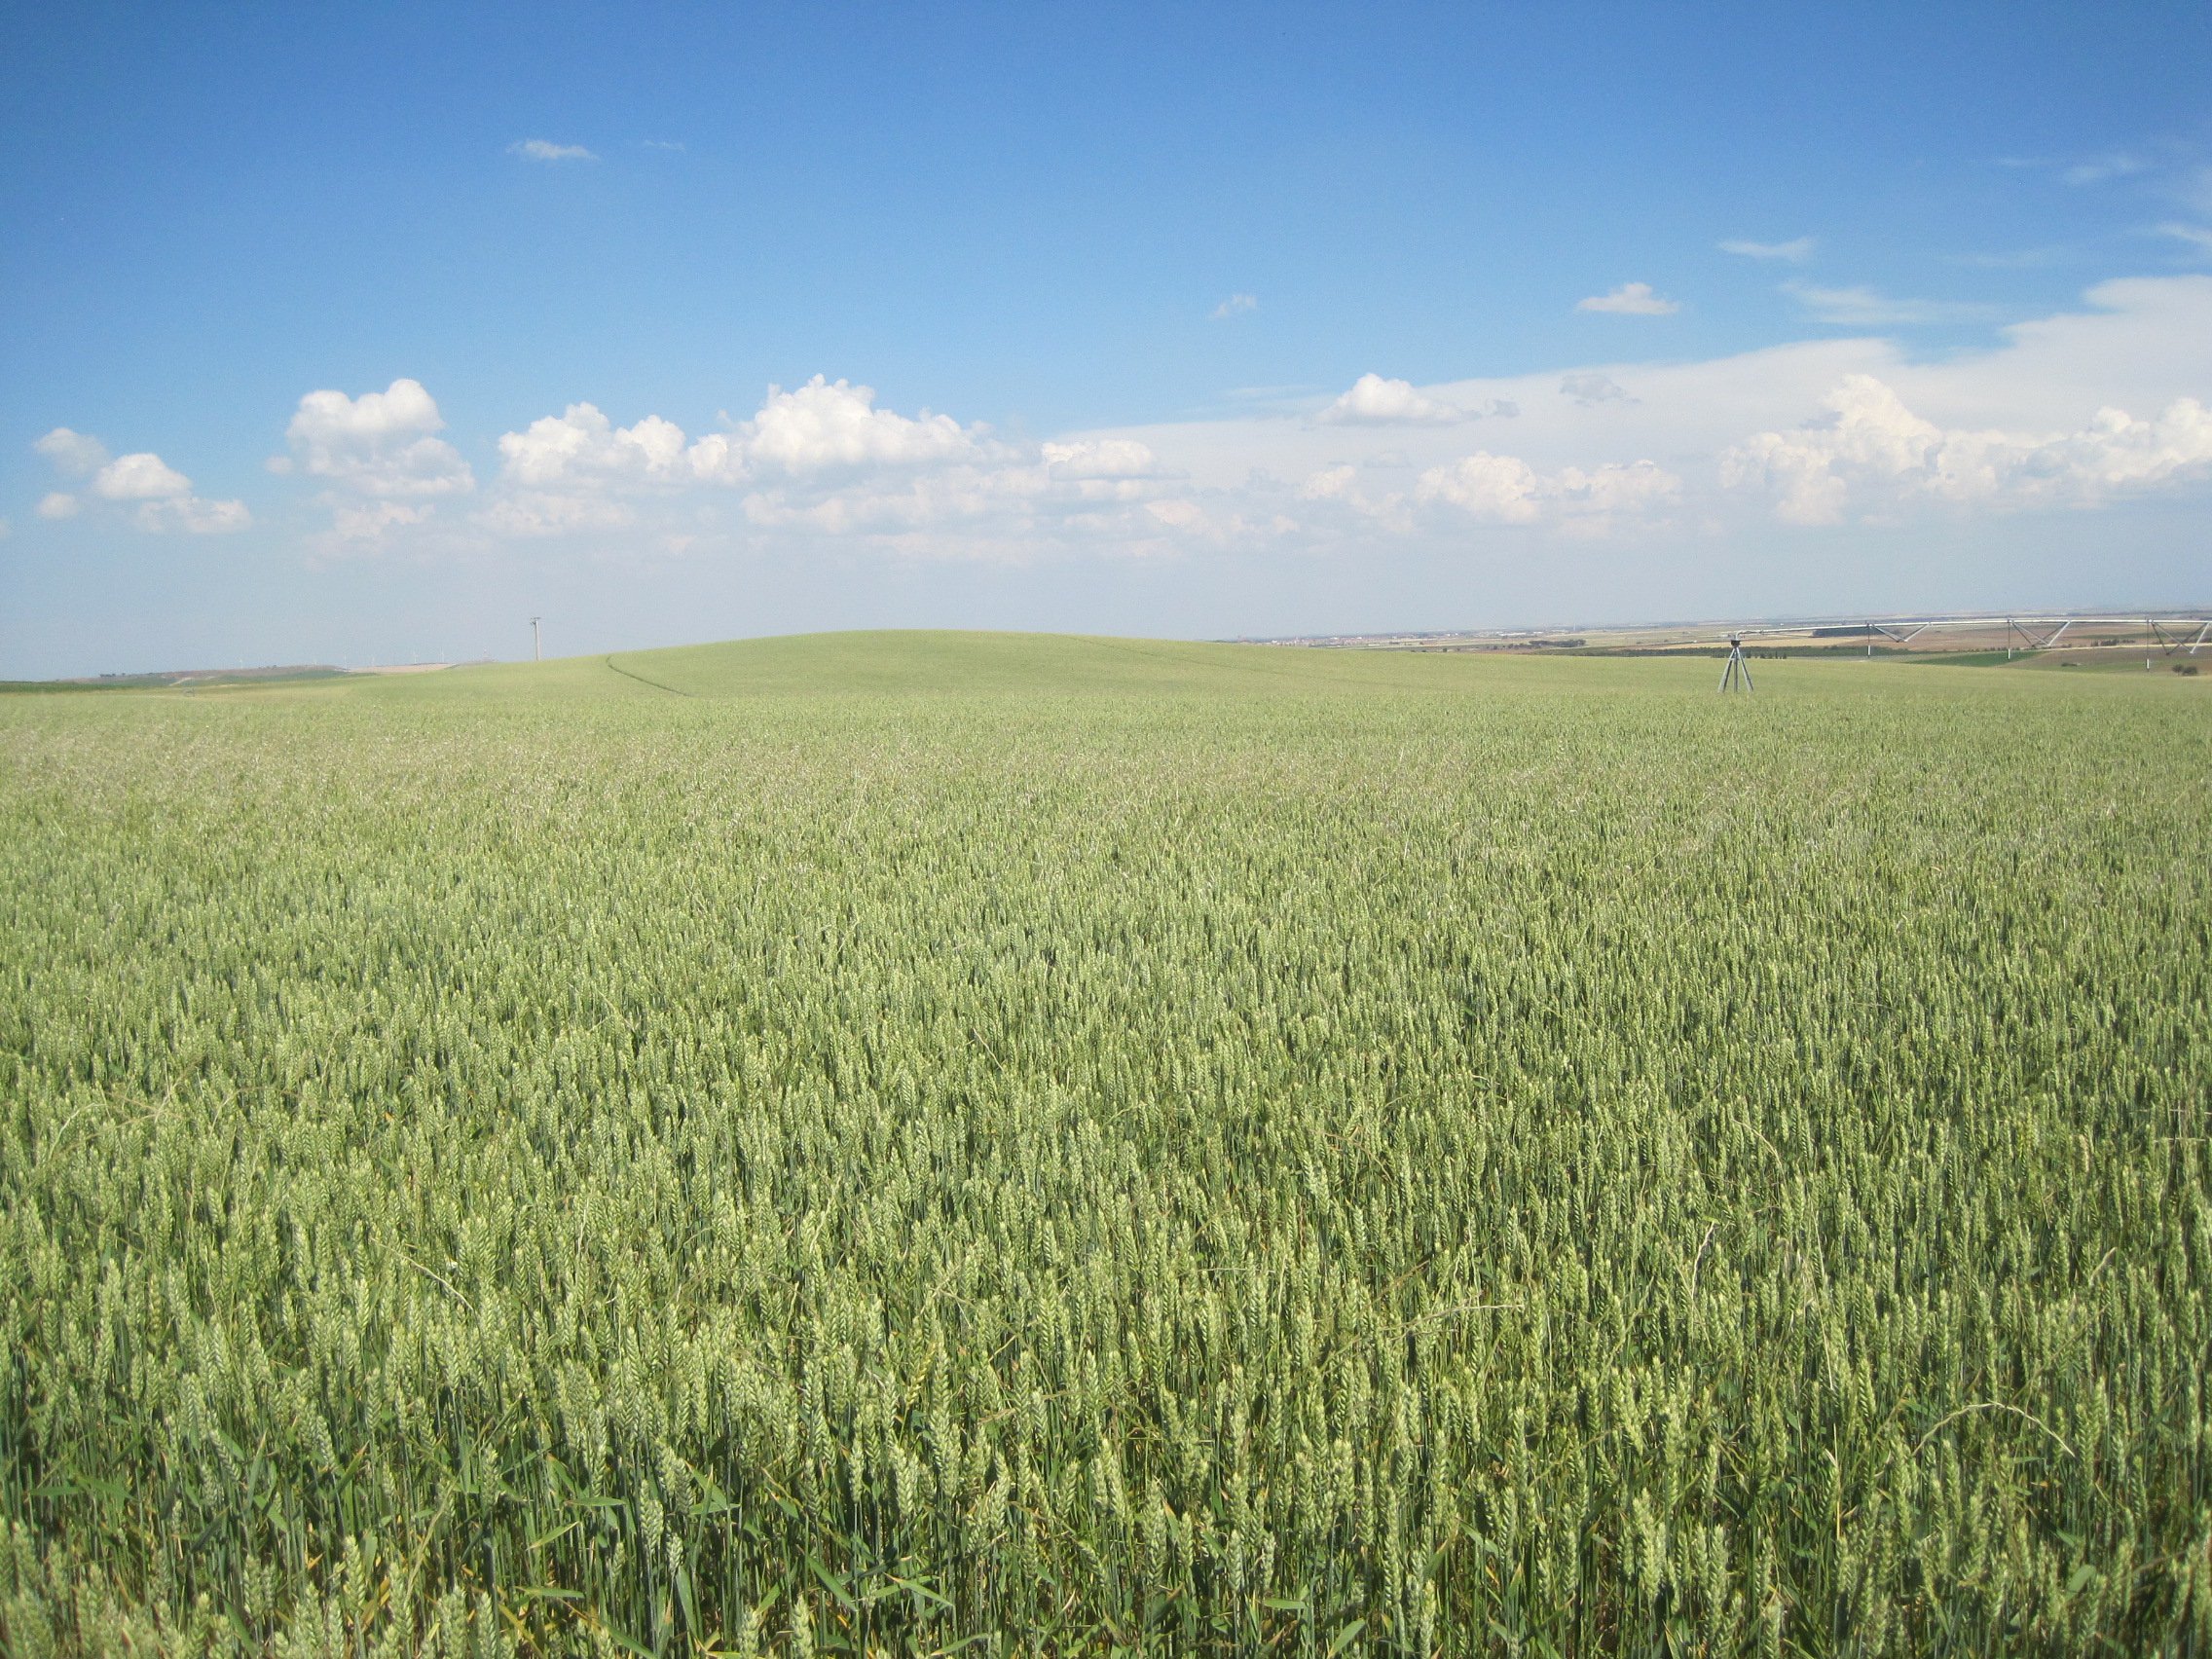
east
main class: Cropland
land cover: Common wheat
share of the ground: > 75 %
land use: Agriculture (excluding fallow land and kitchen gardens)
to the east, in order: Common wheat
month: May
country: ES
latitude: 41.3219
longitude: -5.0397
